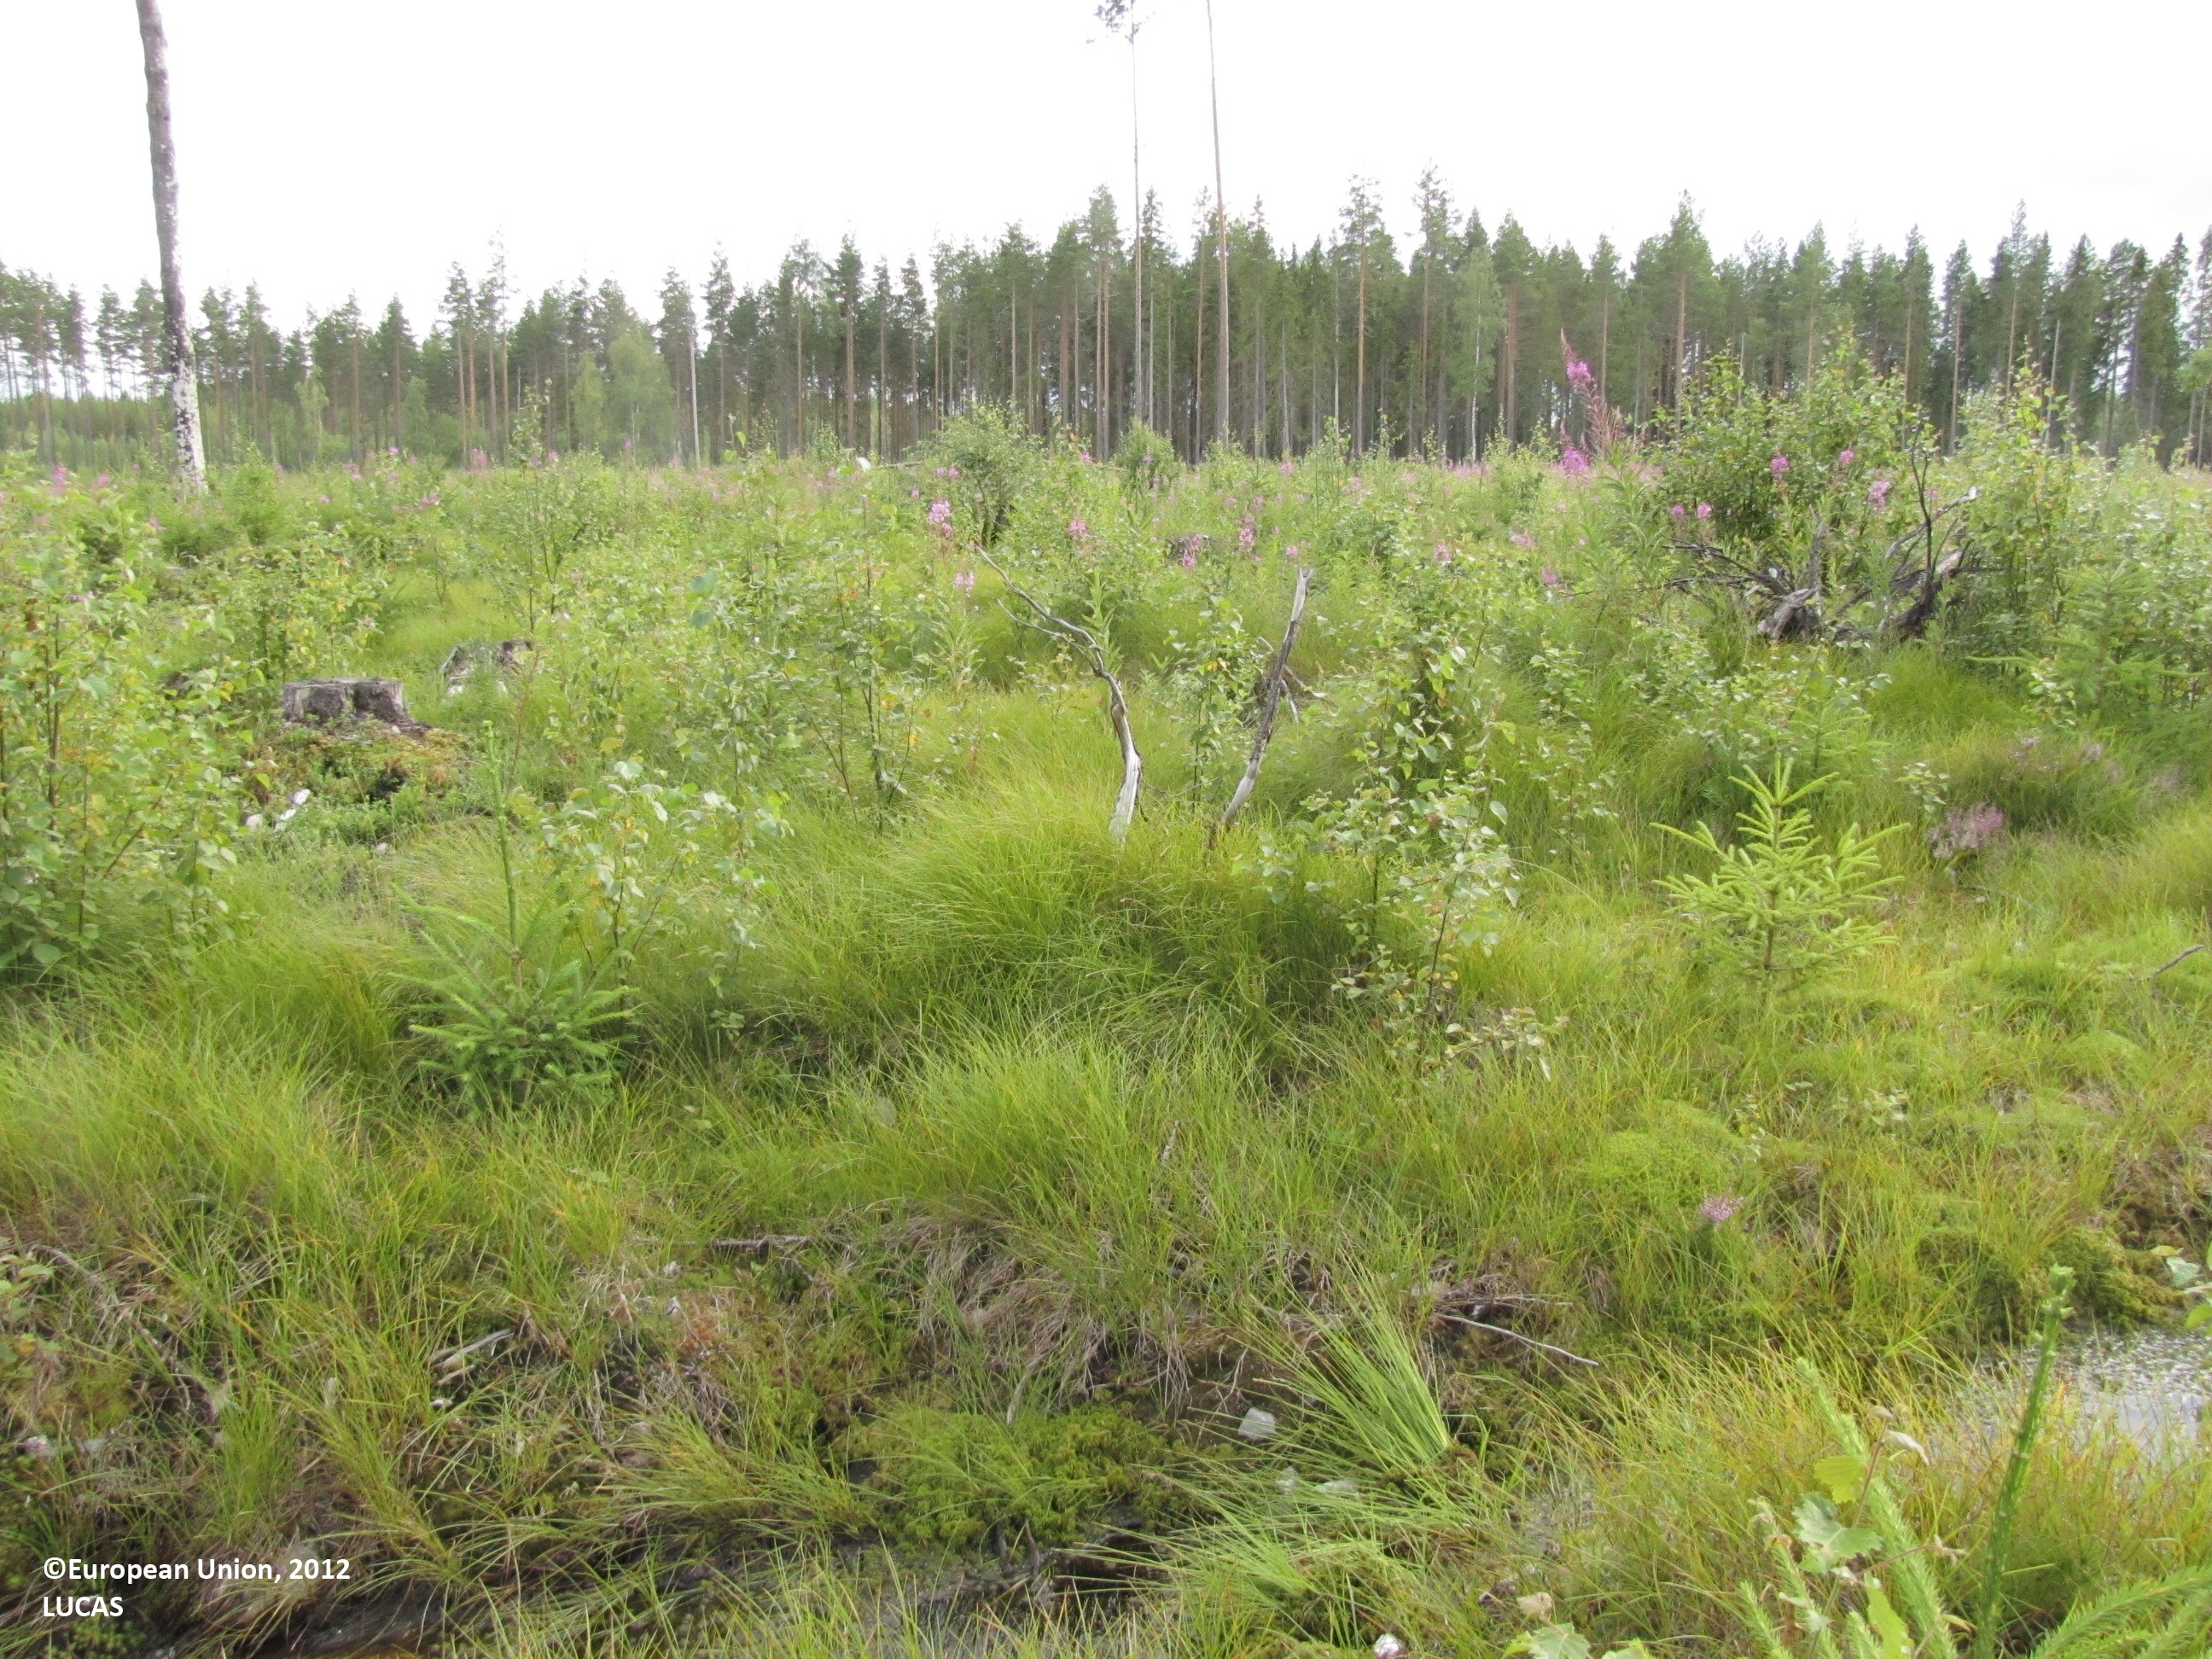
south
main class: Woodland
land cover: Spruce dominated mixed woodland
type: boreal forest
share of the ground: 50 - 75 %
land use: Forestry
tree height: < 5 m
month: July
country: FI
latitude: 62.2885
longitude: 23.1558
